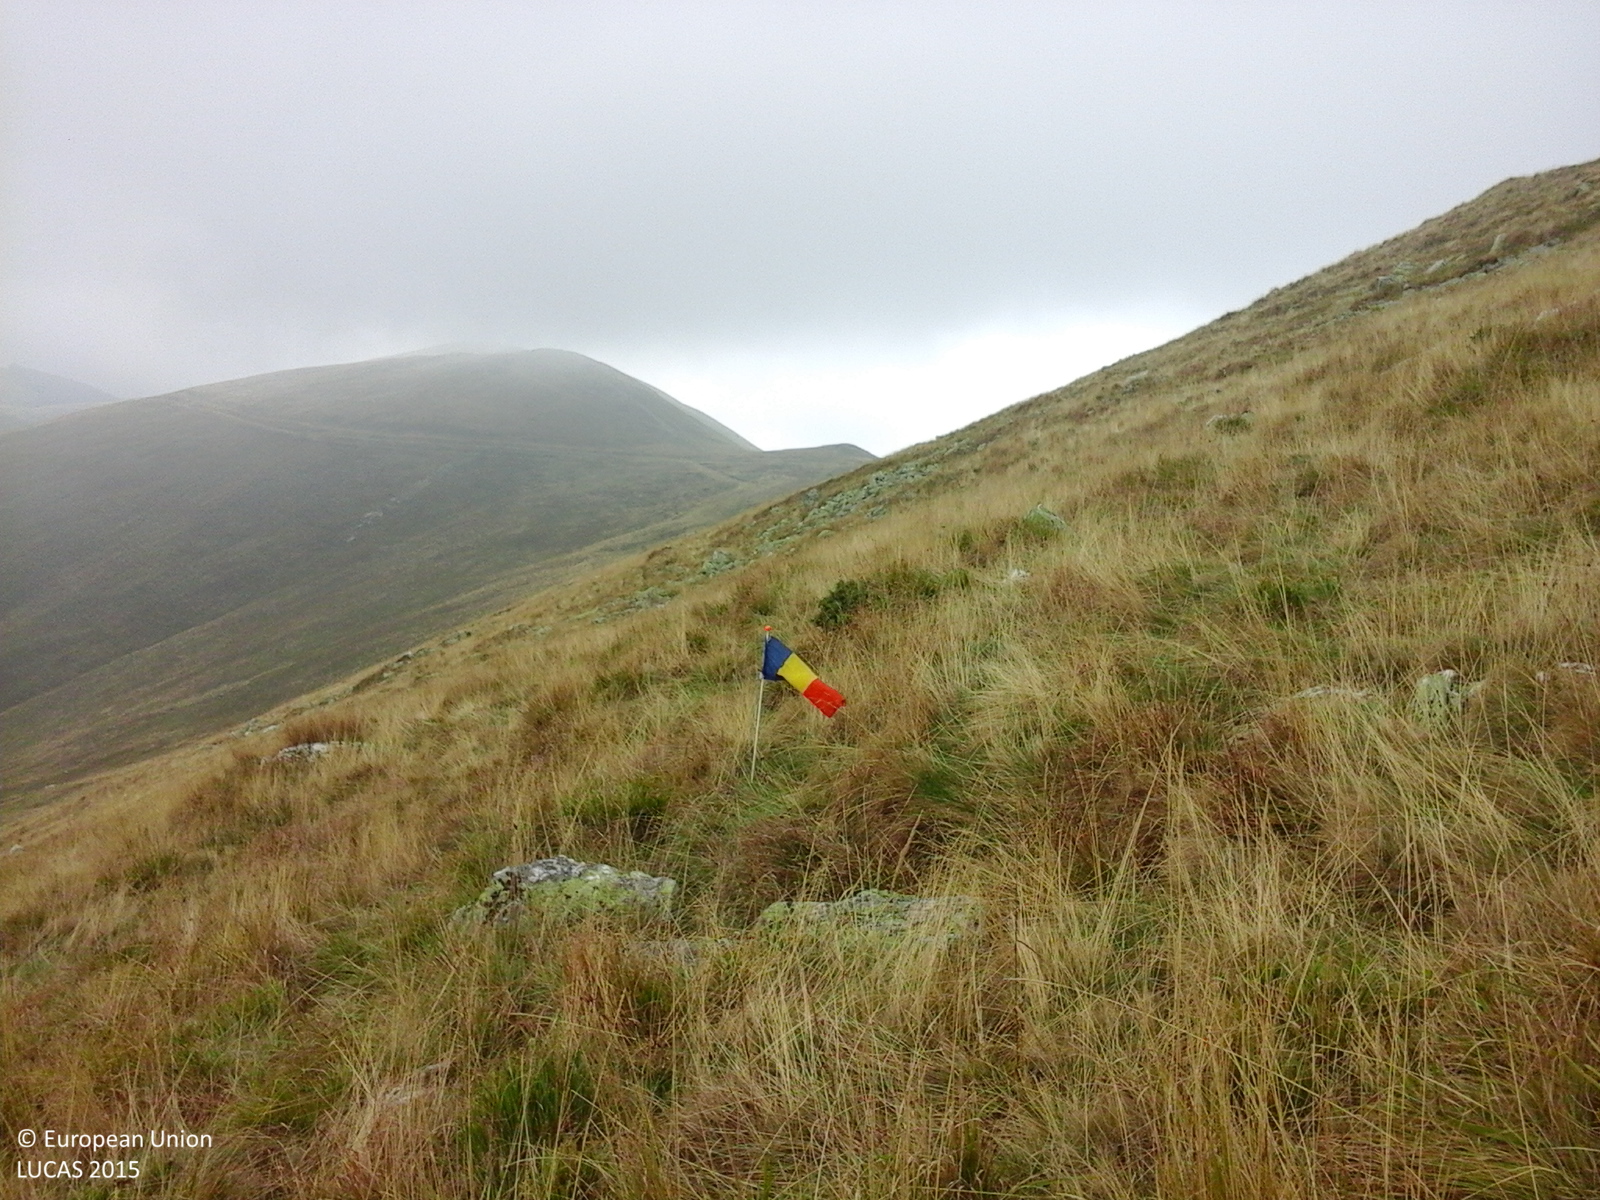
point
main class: Grassland
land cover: Grassland without tree/shrub cover
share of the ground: > 75 %
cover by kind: herbaceous plants 100 %
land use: Agriculture (excluding fallow land and kitchen gardens)
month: September
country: RO
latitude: 45.2966
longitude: 23.3054
